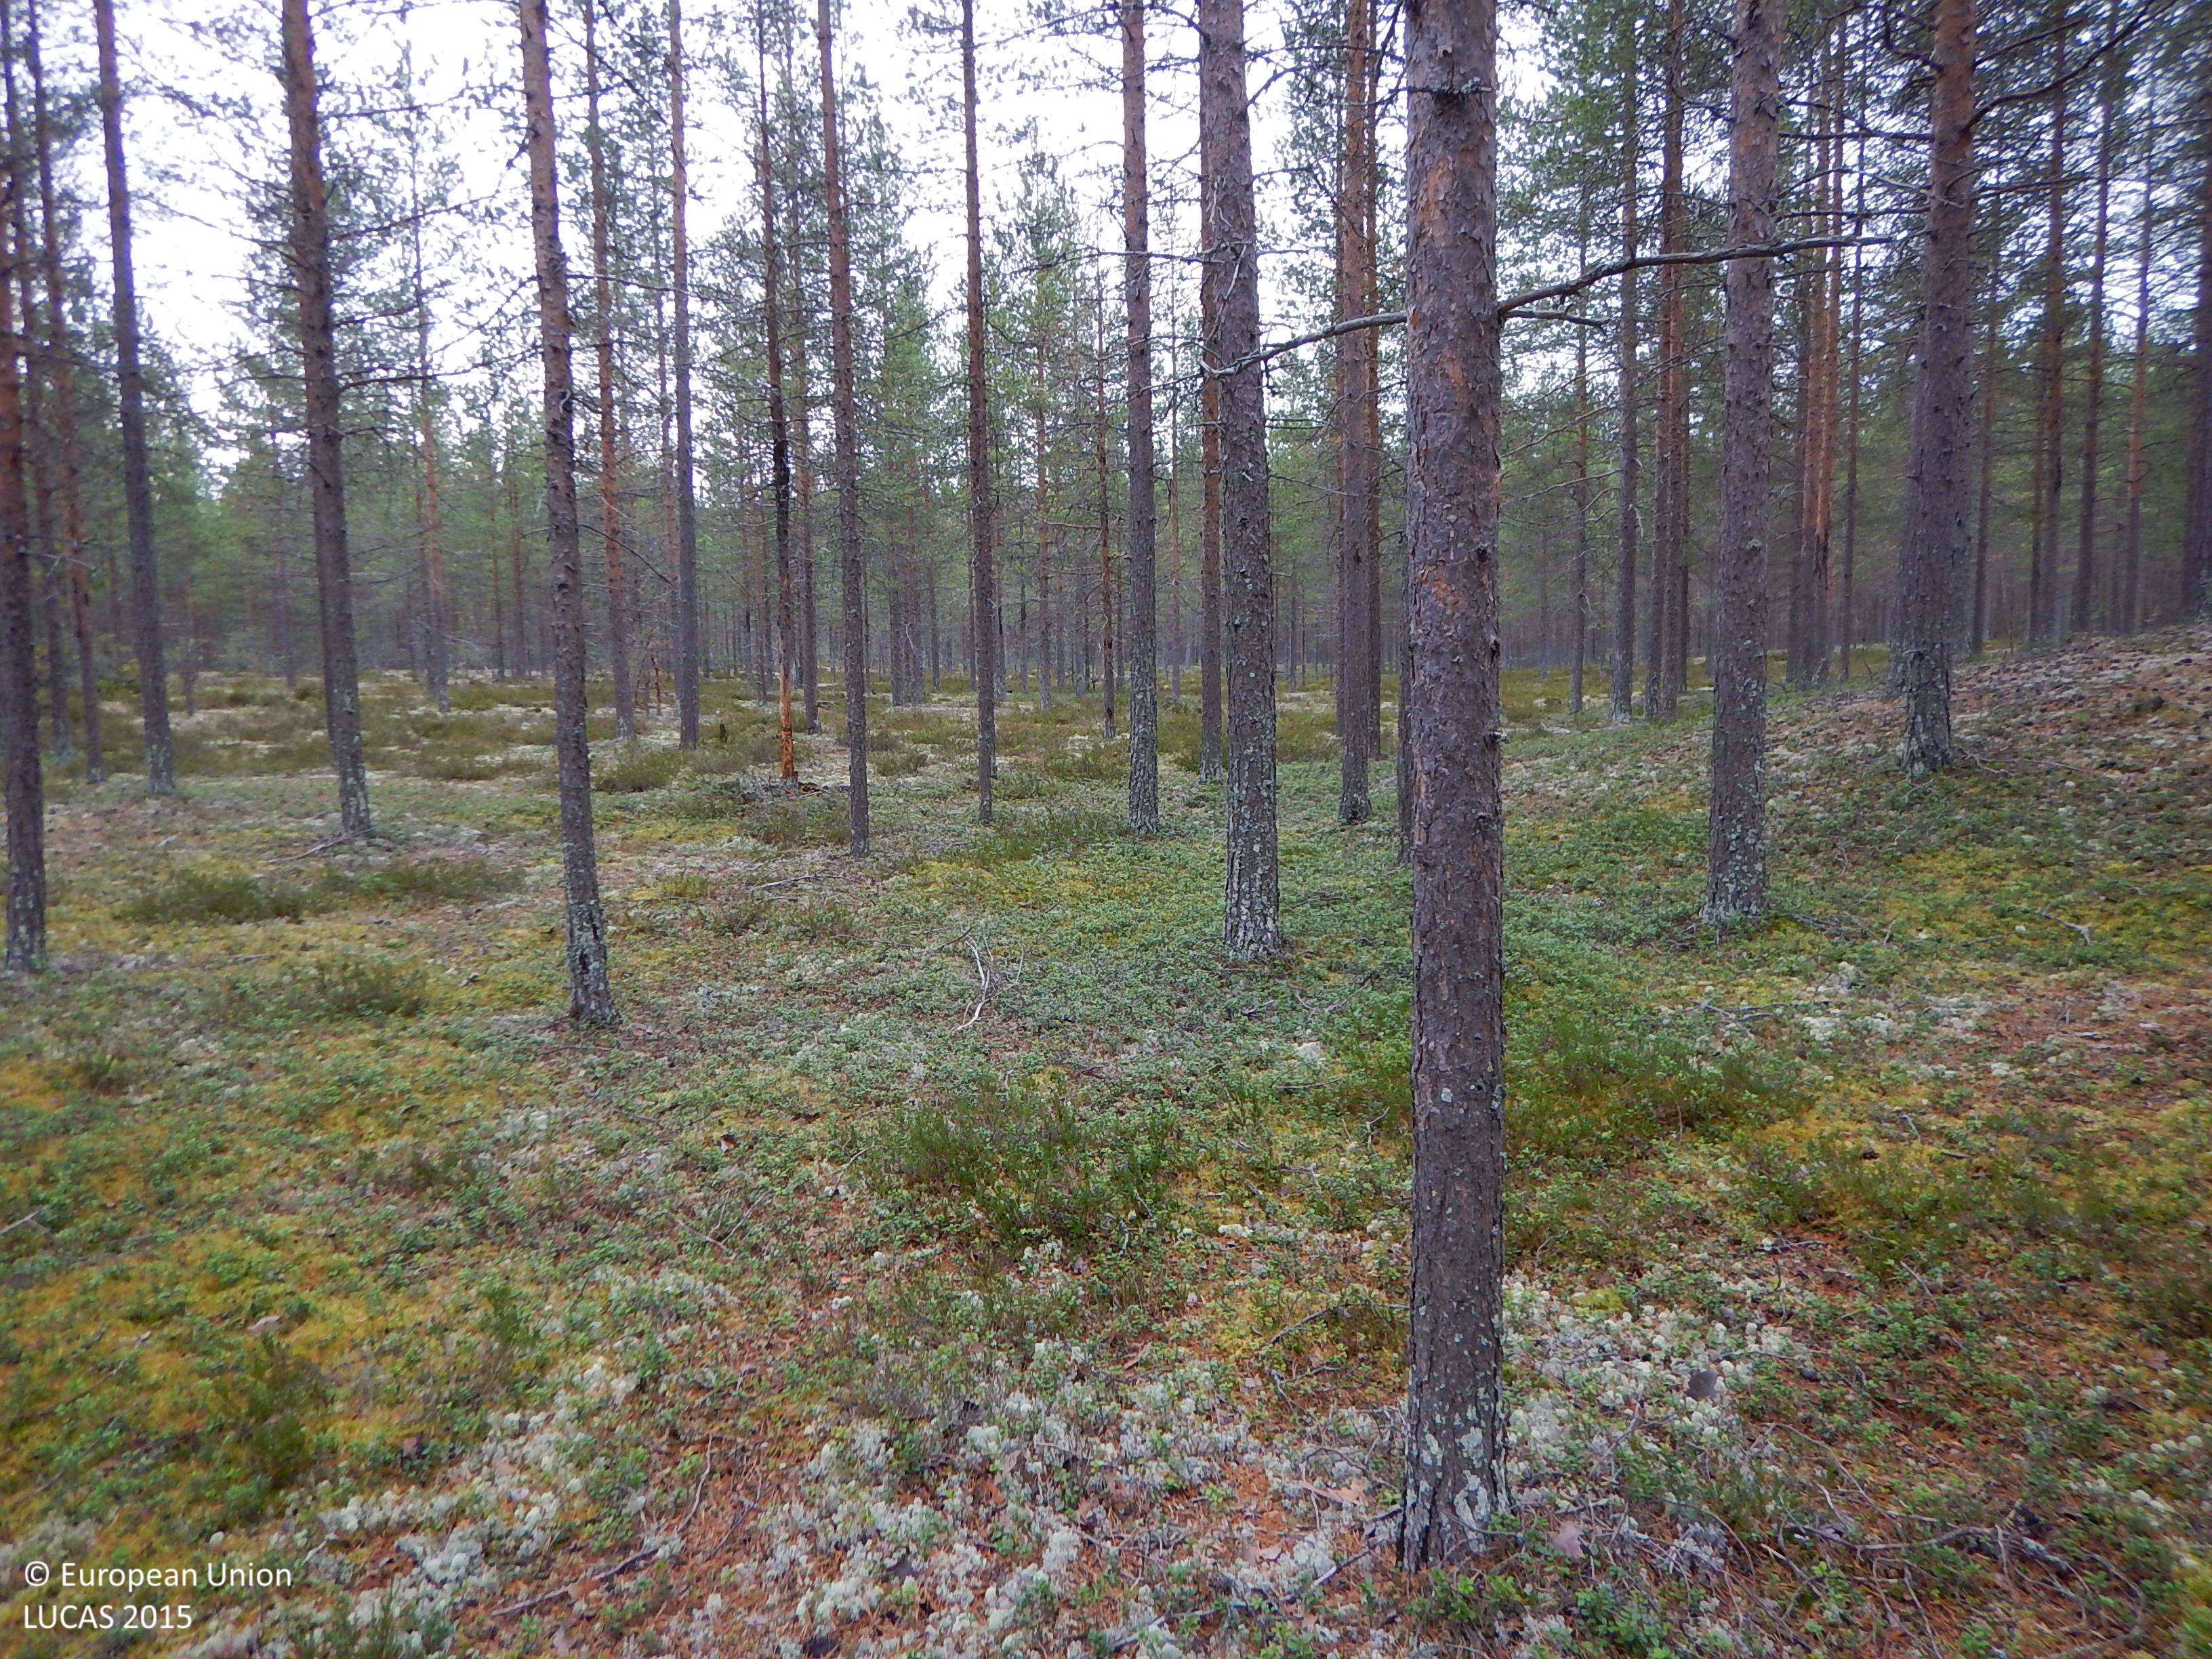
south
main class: Woodland
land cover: Pine dominated coniferous woodland
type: boreal forest
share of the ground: 25 - 50 %
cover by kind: coniferous forest trees 45 %, shrubs 25 %, lichens and mosses 25 %, herbaceous plants 5 %
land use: Forestry
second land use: Amenities, museums, leisure
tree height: > 5 m
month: October
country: SE
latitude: 65.2553
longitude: 21.5611
